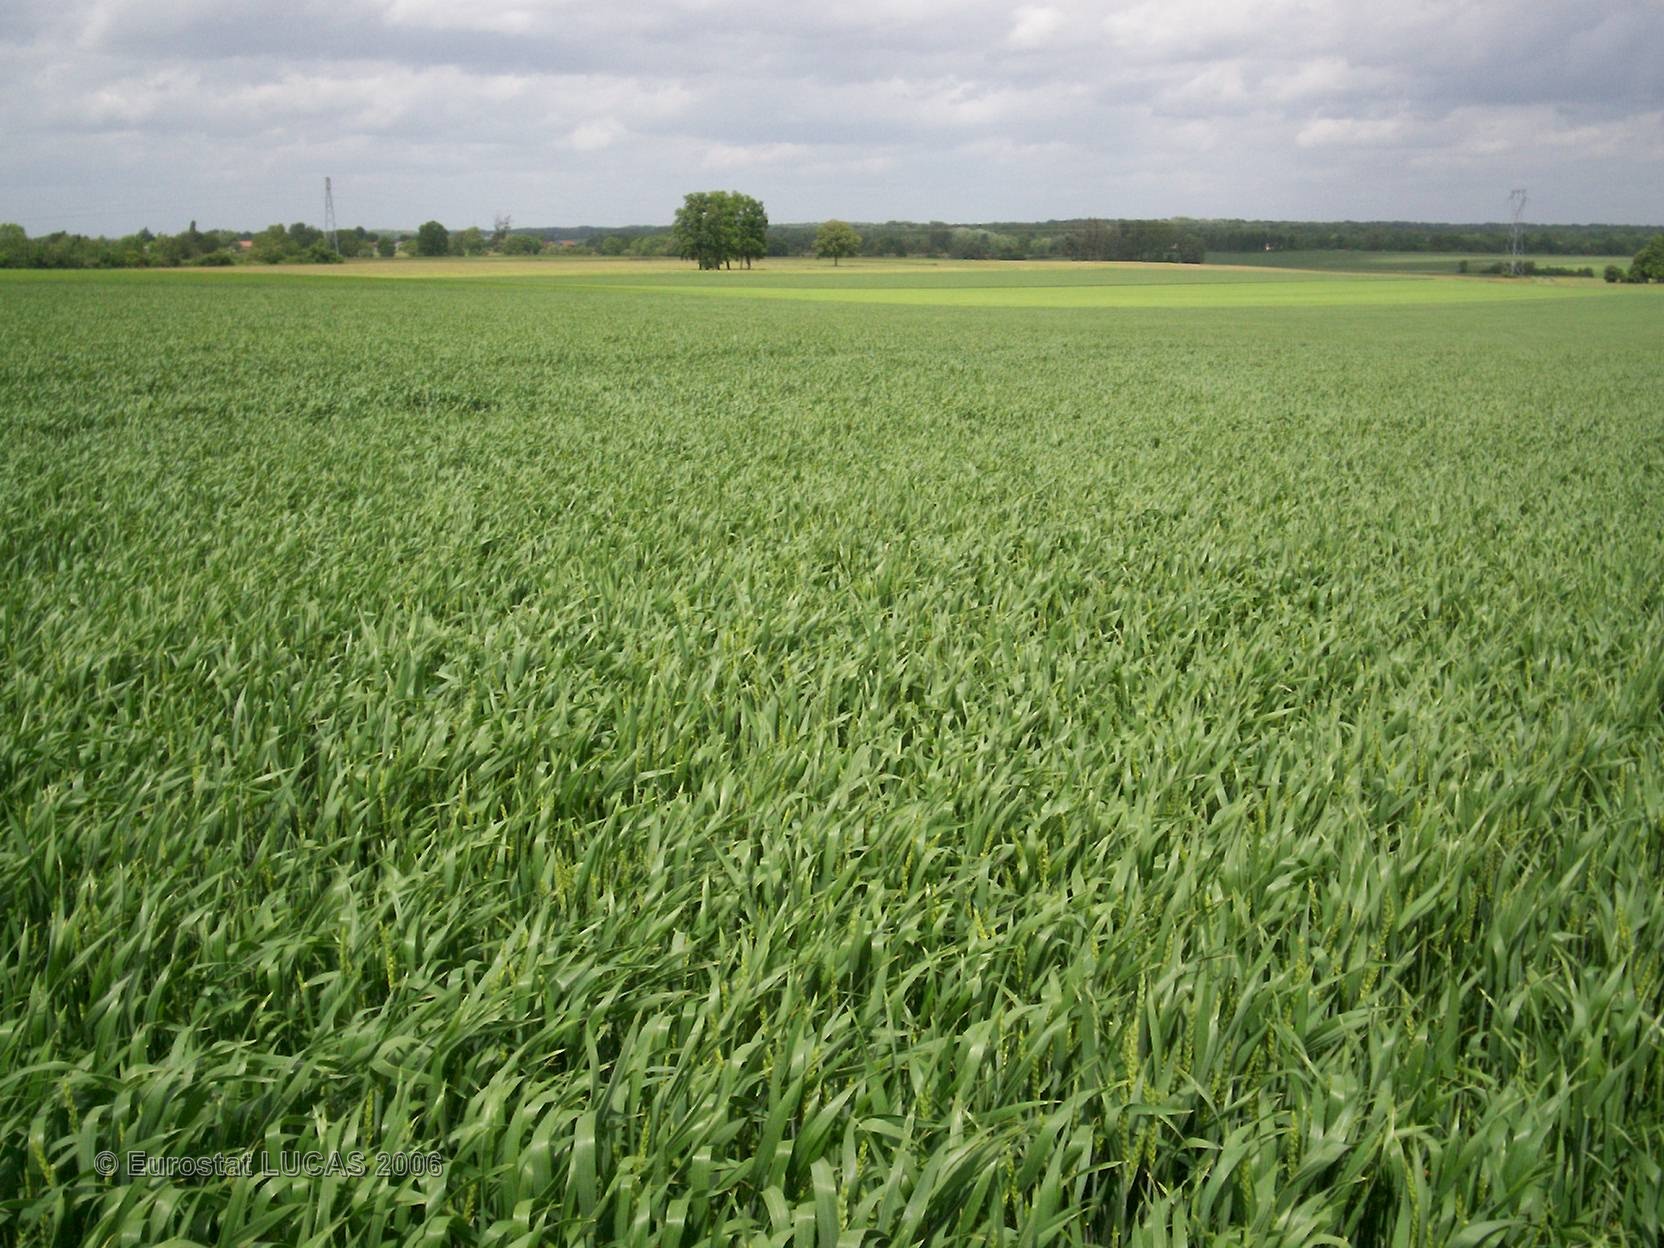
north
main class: Cropland
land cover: Common wheat
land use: Agriculture (excluding fallow land and kitchen gardens)
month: May
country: FR
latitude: 48.3557
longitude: 4.4777
